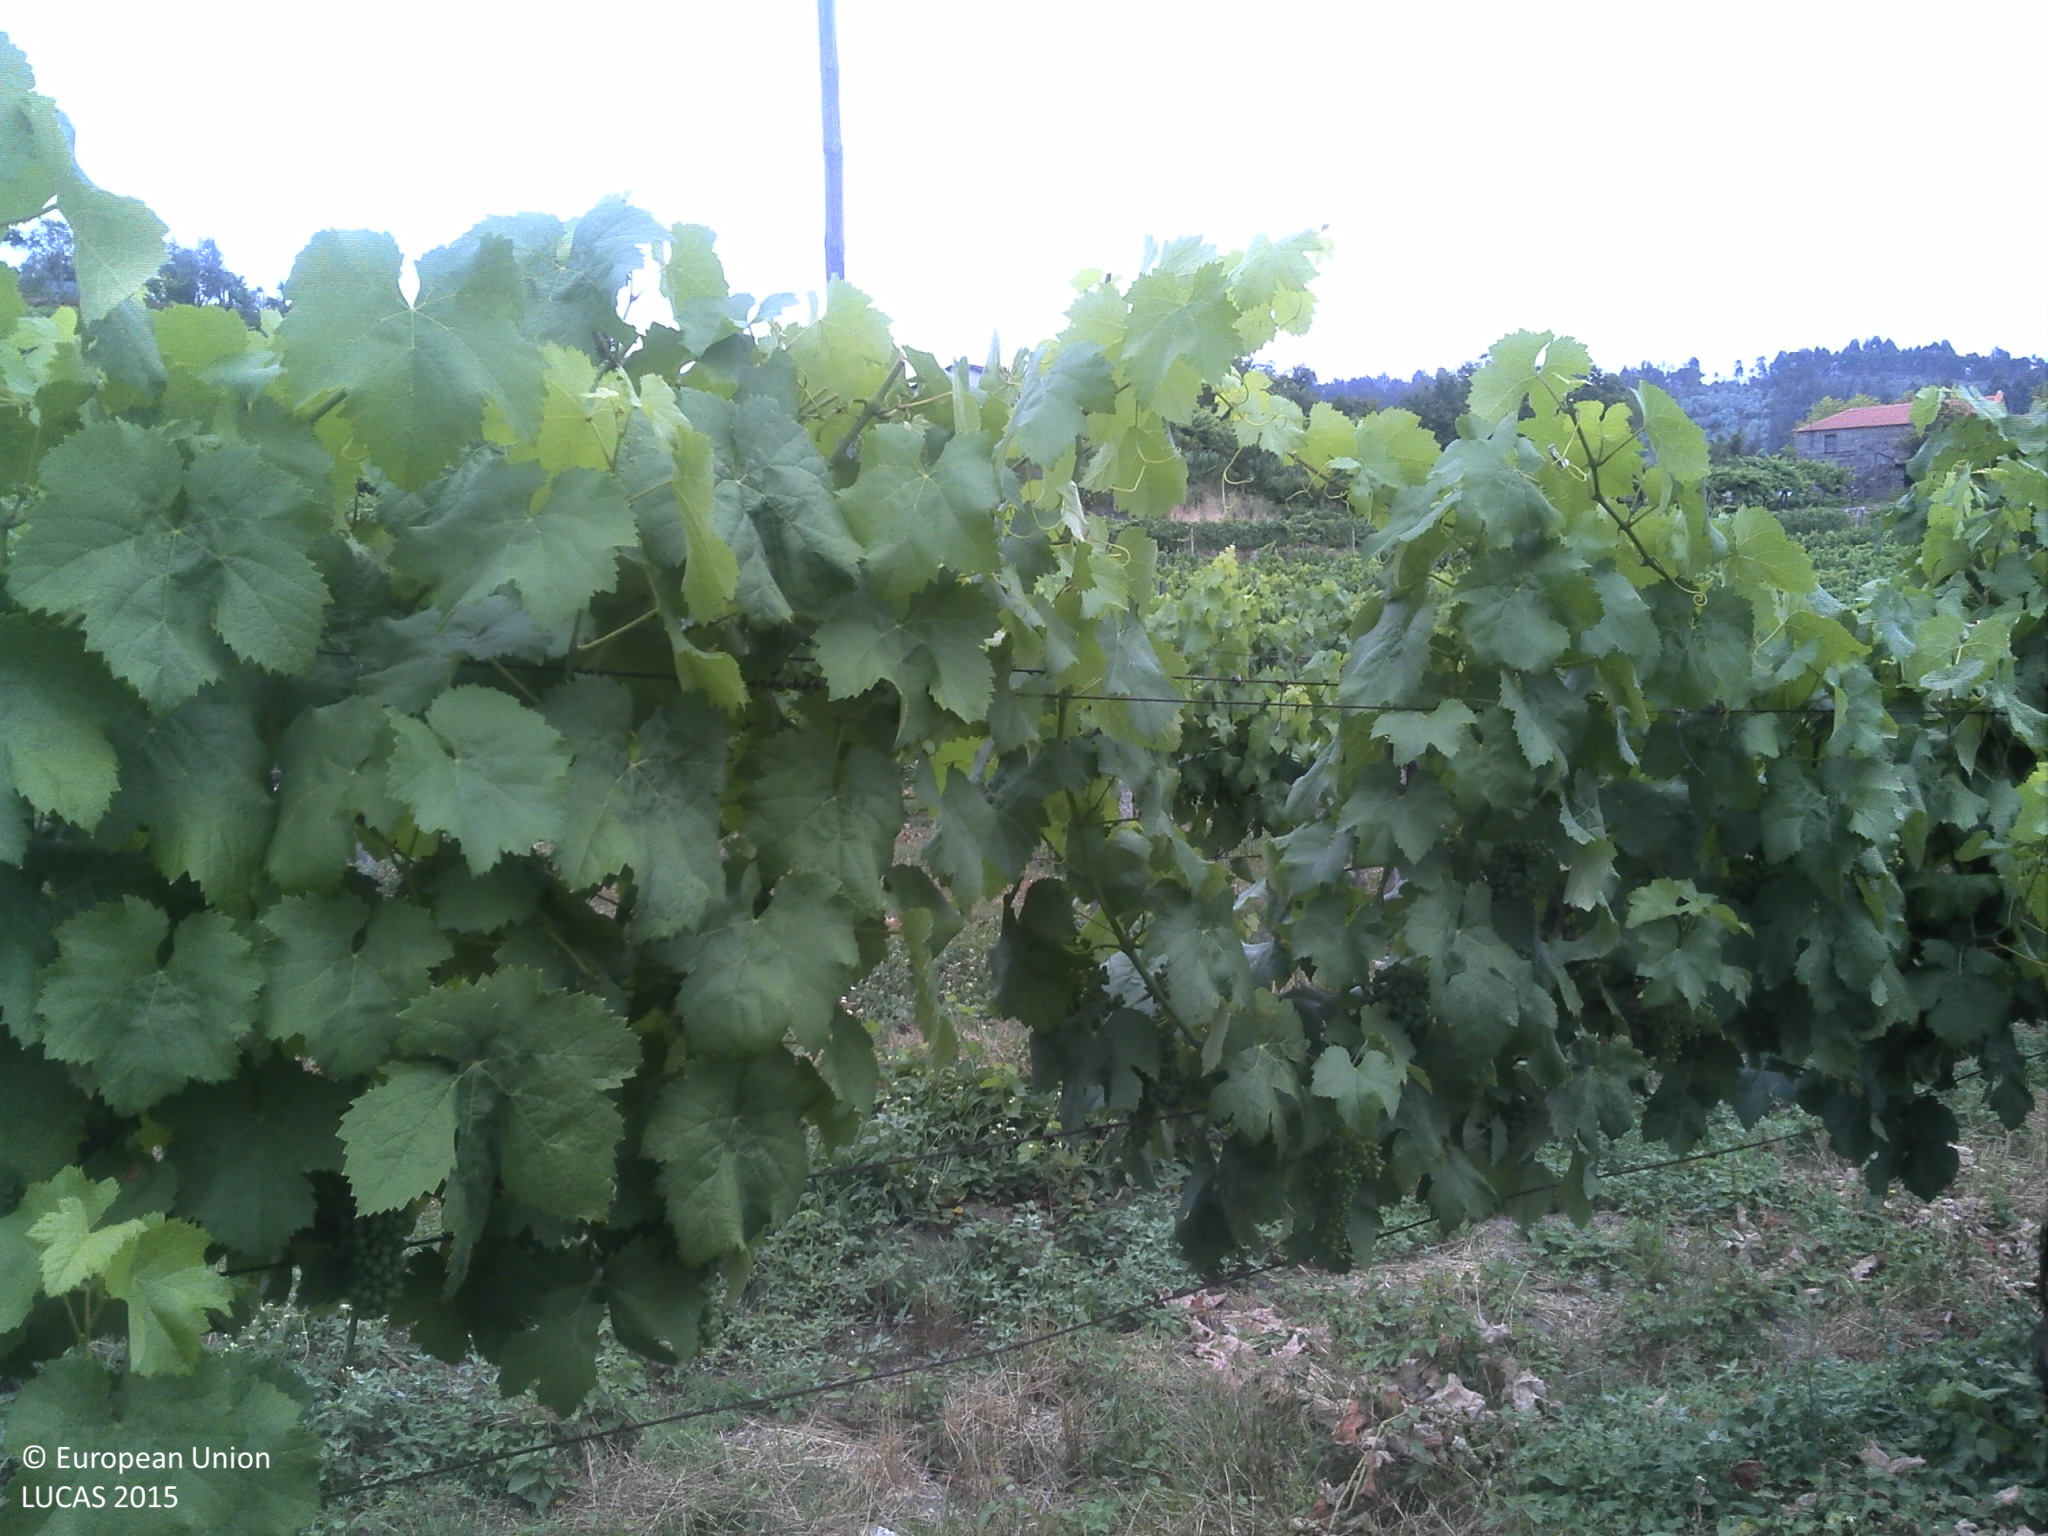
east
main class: Cropland
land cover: Vineyards
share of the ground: 25 - 50 %
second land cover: Grassland without tree/shrub cover
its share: 50 - 75 %
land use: Agriculture (excluding fallow land and kitchen gardens)
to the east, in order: Vineyards; Grassland without tree/shrub cover; Vineyards; Tracks; Vineyards; Shrubland without tree cover; Vineyards; Maize; Vineyards; Maize; Vineyards; Other fresh vegetables; Vineyards; Other fruit trees and berries; Other fresh vegetables; Other fruit trees and berries; Dry stone walls; Other fresh vegetables; Dry stone walls; Other fresh vegetables; Electric lines; Vineyards; Artificial constructions in urban areas
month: June
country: PT
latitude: 41.2345
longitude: -8.1687
